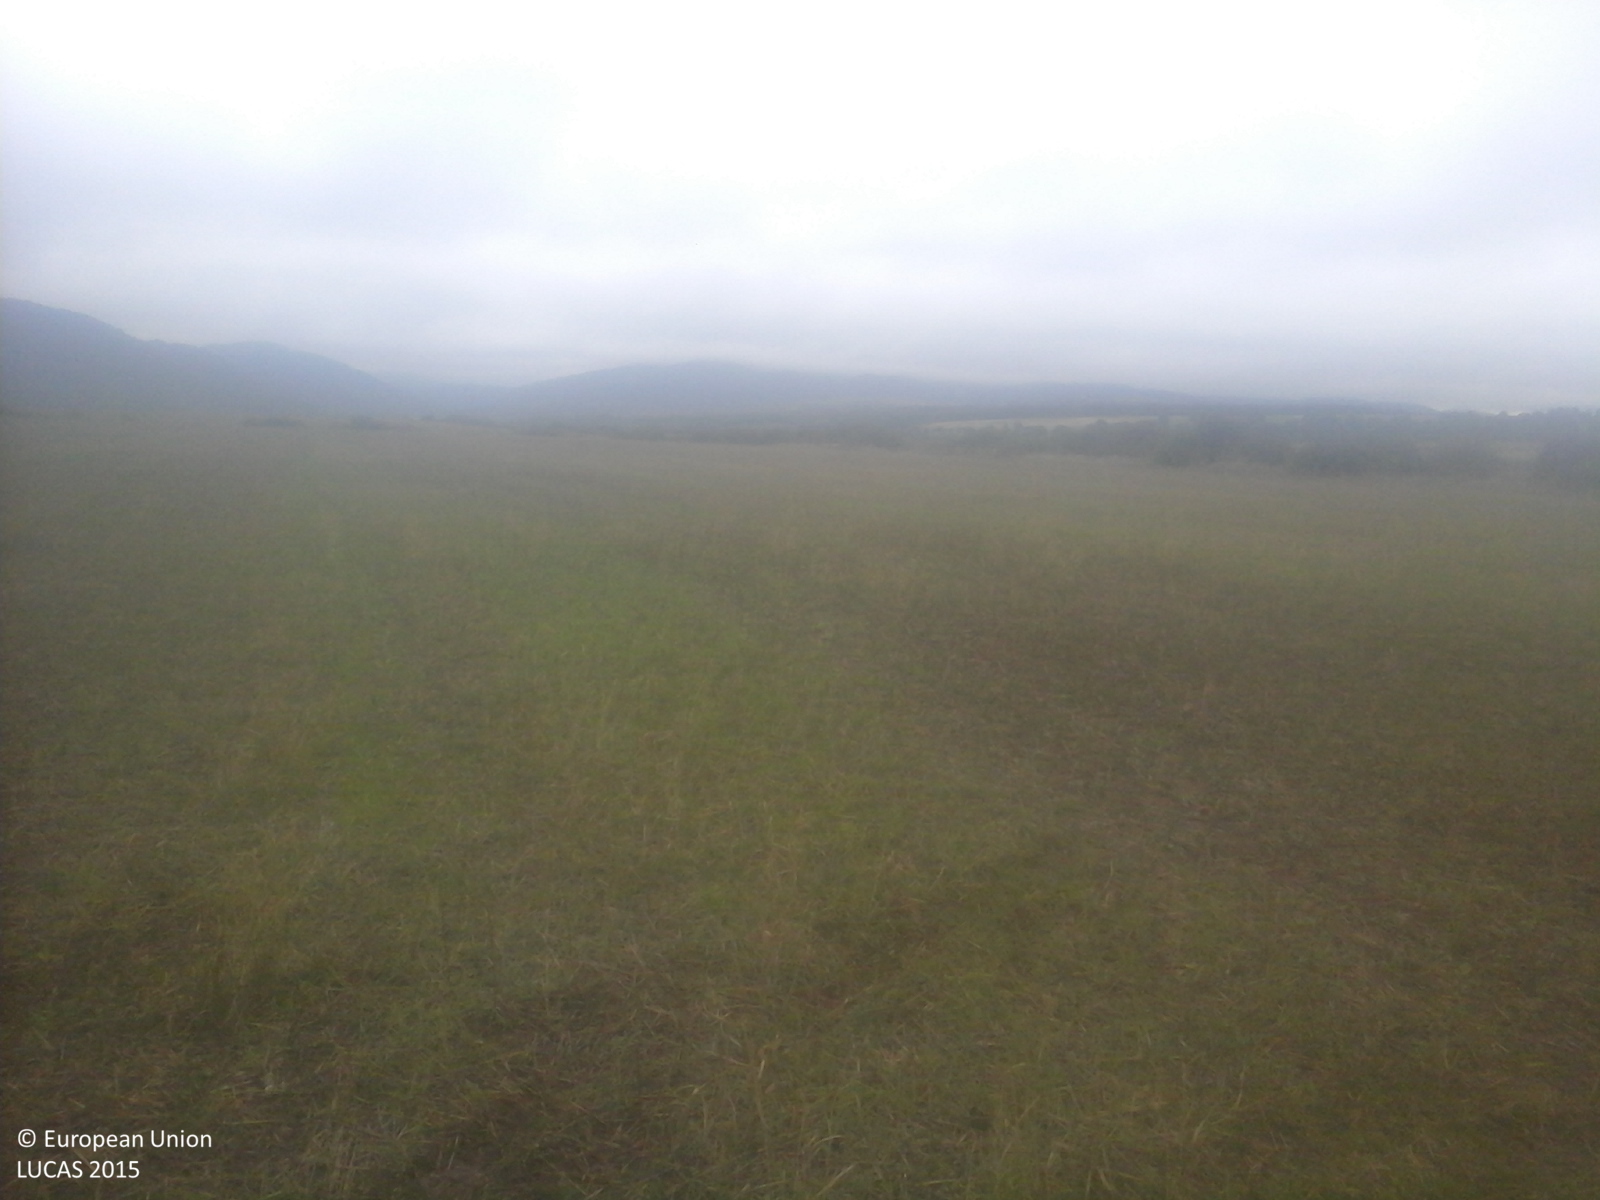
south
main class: Cropland
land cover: Common wheat
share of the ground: 25 - 50 %
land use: Agriculture (excluding fallow land and kitchen gardens)
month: September
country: RO
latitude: 45.9334
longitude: 23.4633
